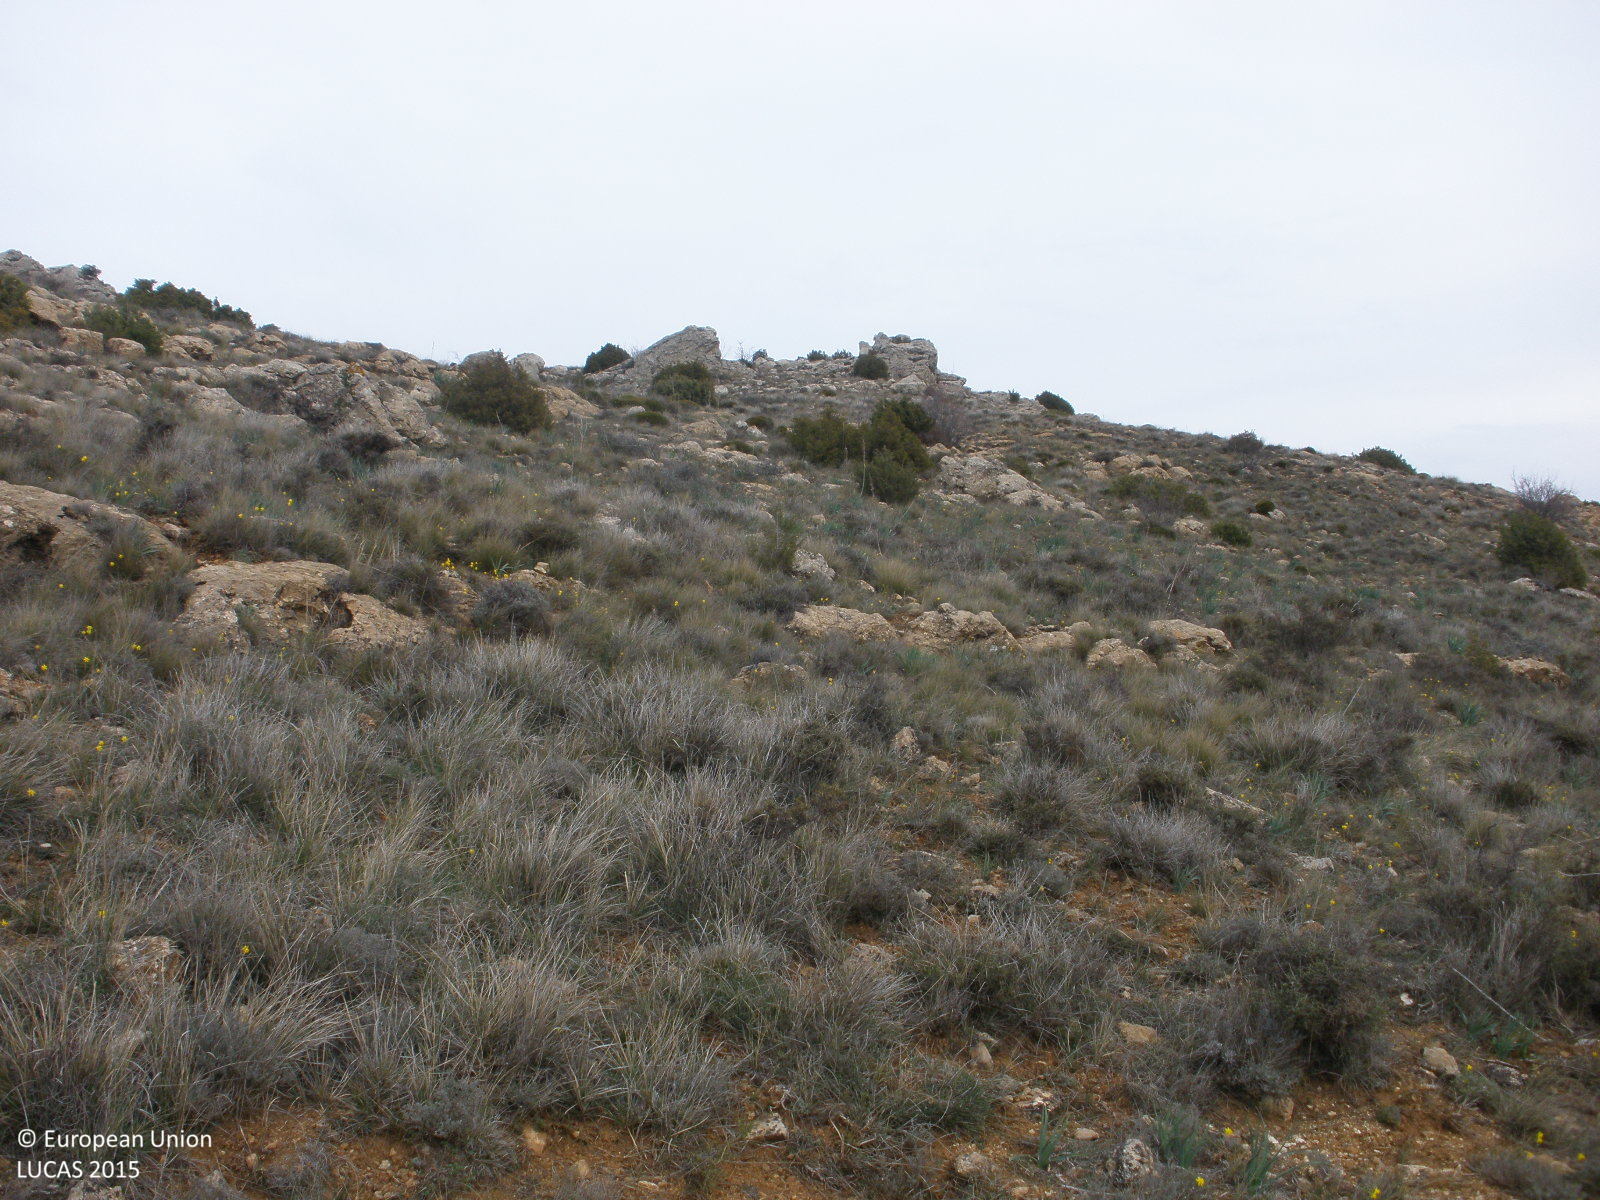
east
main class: Shrubland
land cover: Shrubland without tree cover
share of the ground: 50 - 75 %
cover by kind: consolidated bare surface 50 %, shrubs 30 %, herbaceous plants 20 %
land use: Semi-natural and natural areas not in use
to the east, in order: Shrubland without tree cover; Rock outcrops; Shrubland without tree cover; Dry stone walls; Shrubland without tree cover
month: April
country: ES
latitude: 41.0407
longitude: -1.0926
